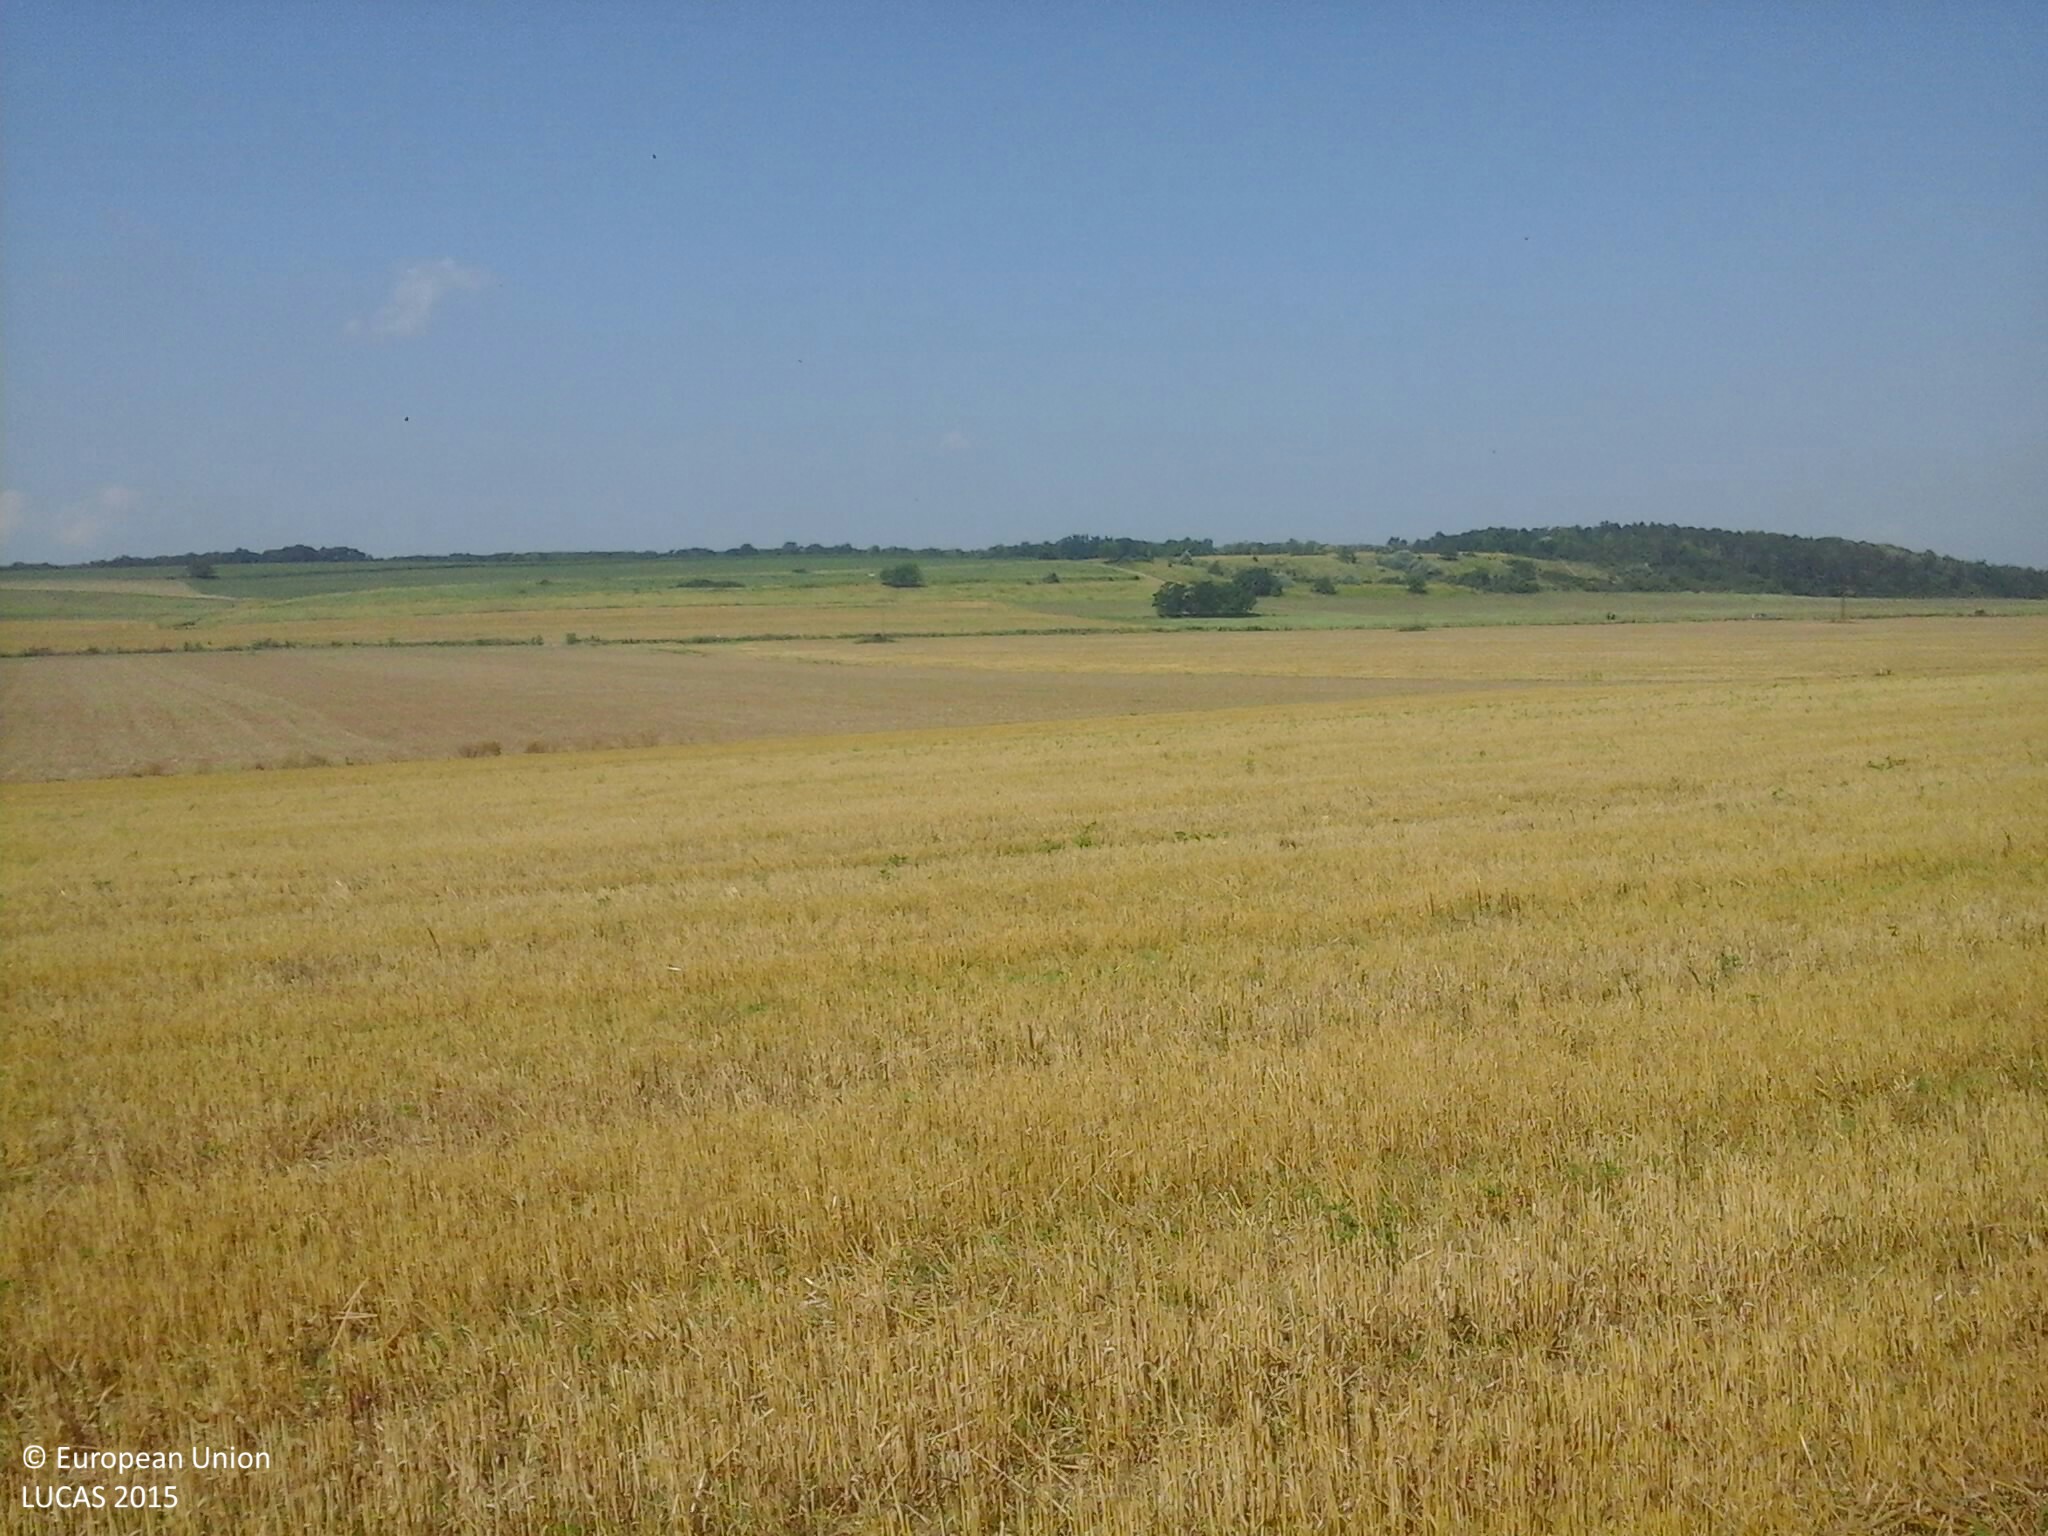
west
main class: Cropland
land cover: Barley
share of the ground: 10 - 25 %
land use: Agriculture (excluding fallow land and kitchen gardens)
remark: Harvested field
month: August
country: HU
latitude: 46.8279
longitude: 18.0184
